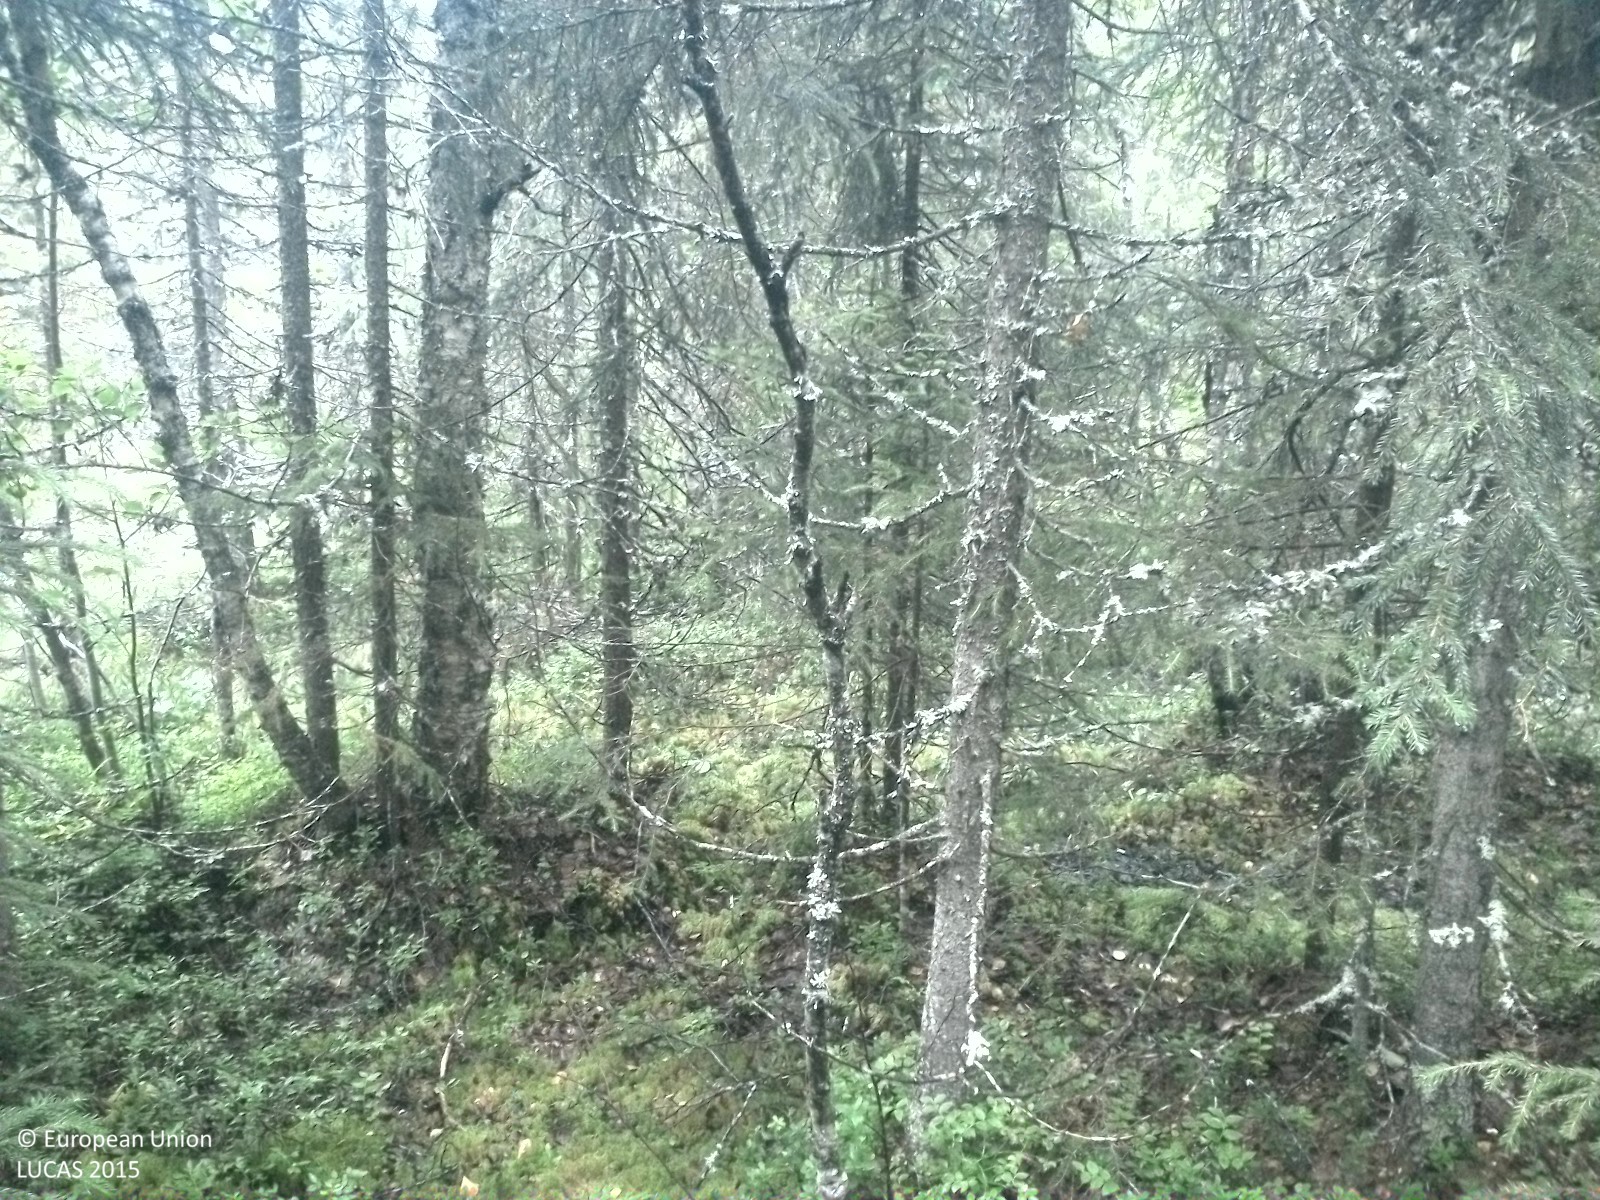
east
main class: Woodland
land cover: Spruce dominated mixed woodland
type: boreal forest
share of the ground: > 75 %
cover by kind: broadleaved forest trees 50 %, coniferous forest trees 35 %, shrubs 15 %
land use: Semi-natural and natural areas not in use
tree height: > 5 m
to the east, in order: Spruce dominated mixed woodland; Ditches and canals; Other mixed woodland; Ditches and canals; Other mixed woodland; Other bare soil; Spruce dominated coniferous woodland; Rivers and streams; Spruce dominated mixed woodland; Other bare soil
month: August
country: SE
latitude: 62.3002
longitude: 16.2859
